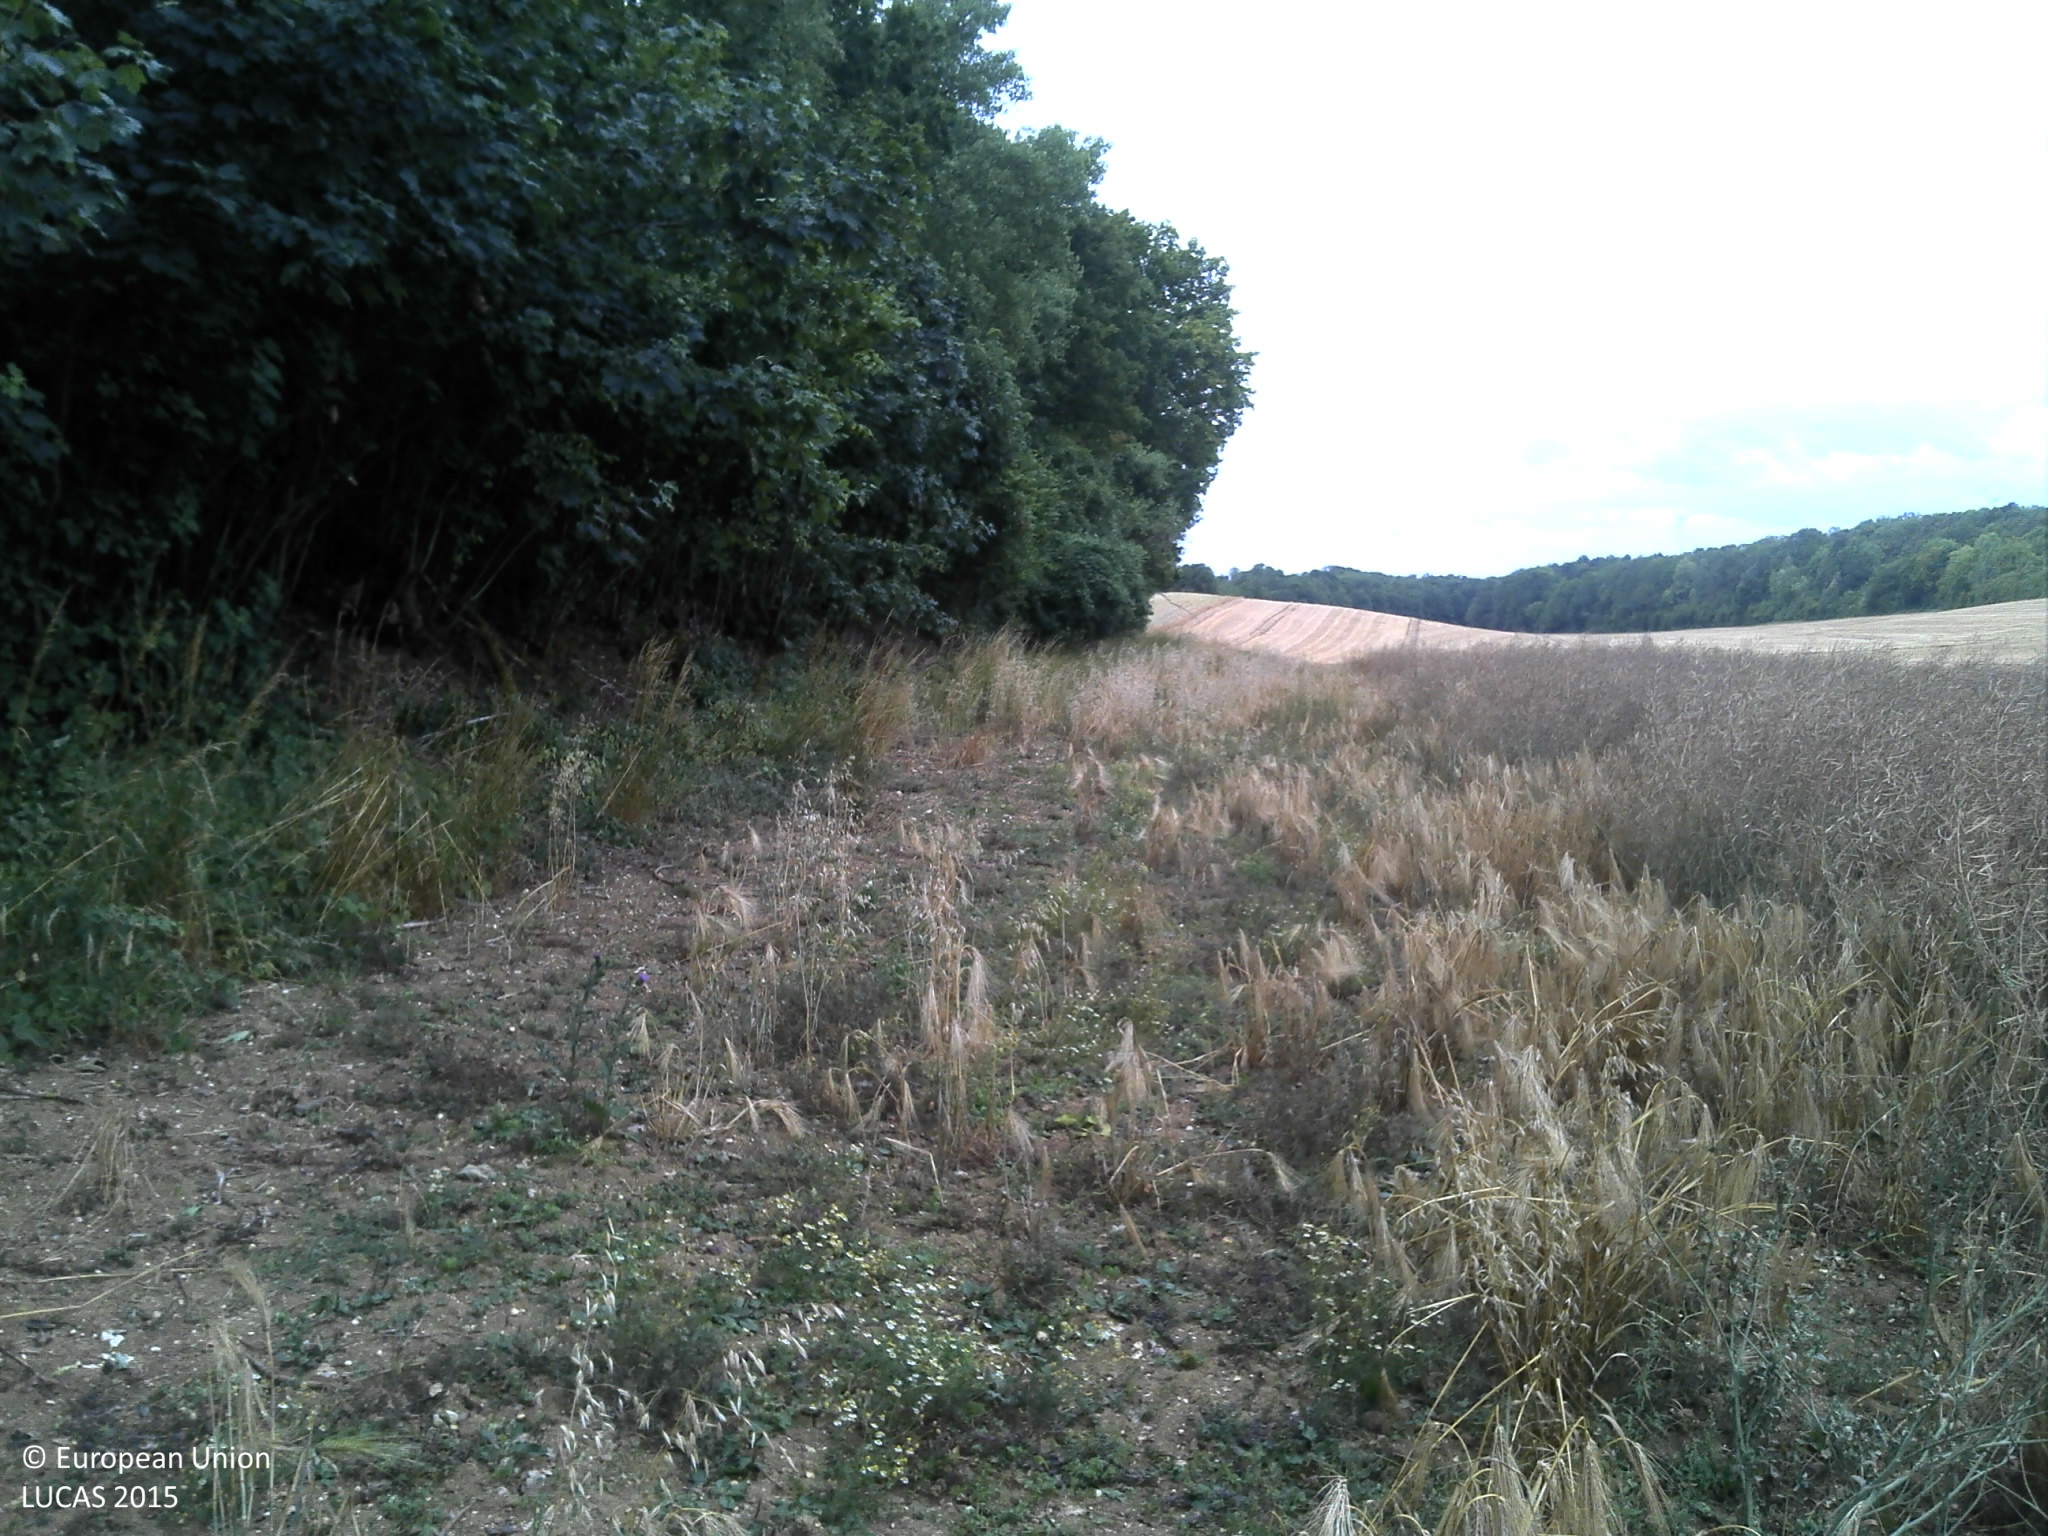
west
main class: Cropland
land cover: Rape and turnip rape
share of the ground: > 75 %
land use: Agriculture (excluding fallow land and kitchen gardens)
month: July
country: FR
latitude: 49.5472
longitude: 4.1487
